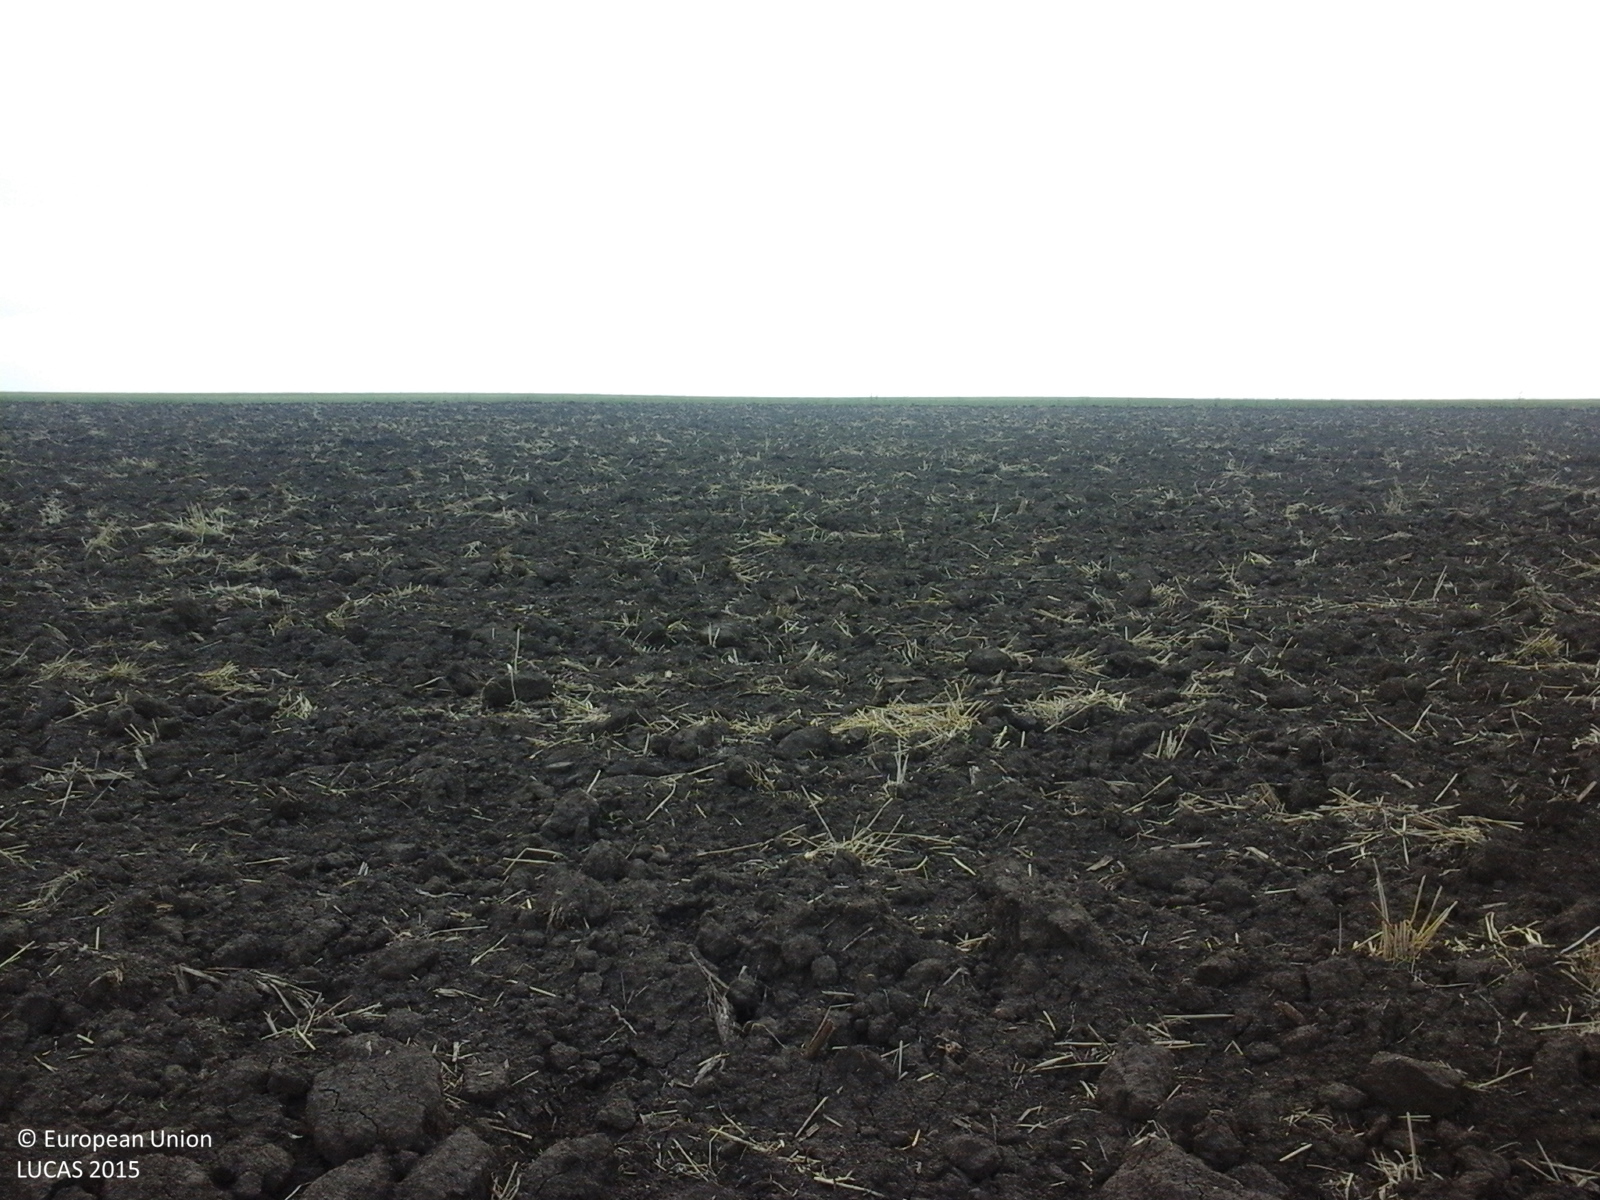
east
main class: Cropland
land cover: Common wheat
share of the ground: < 10 %
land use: Agriculture (excluding fallow land and kitchen gardens)
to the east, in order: Common wheat; Grass margins; Tracks; Grass margins; Common wheat
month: August
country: RO
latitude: 43.8053
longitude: 28.1404
